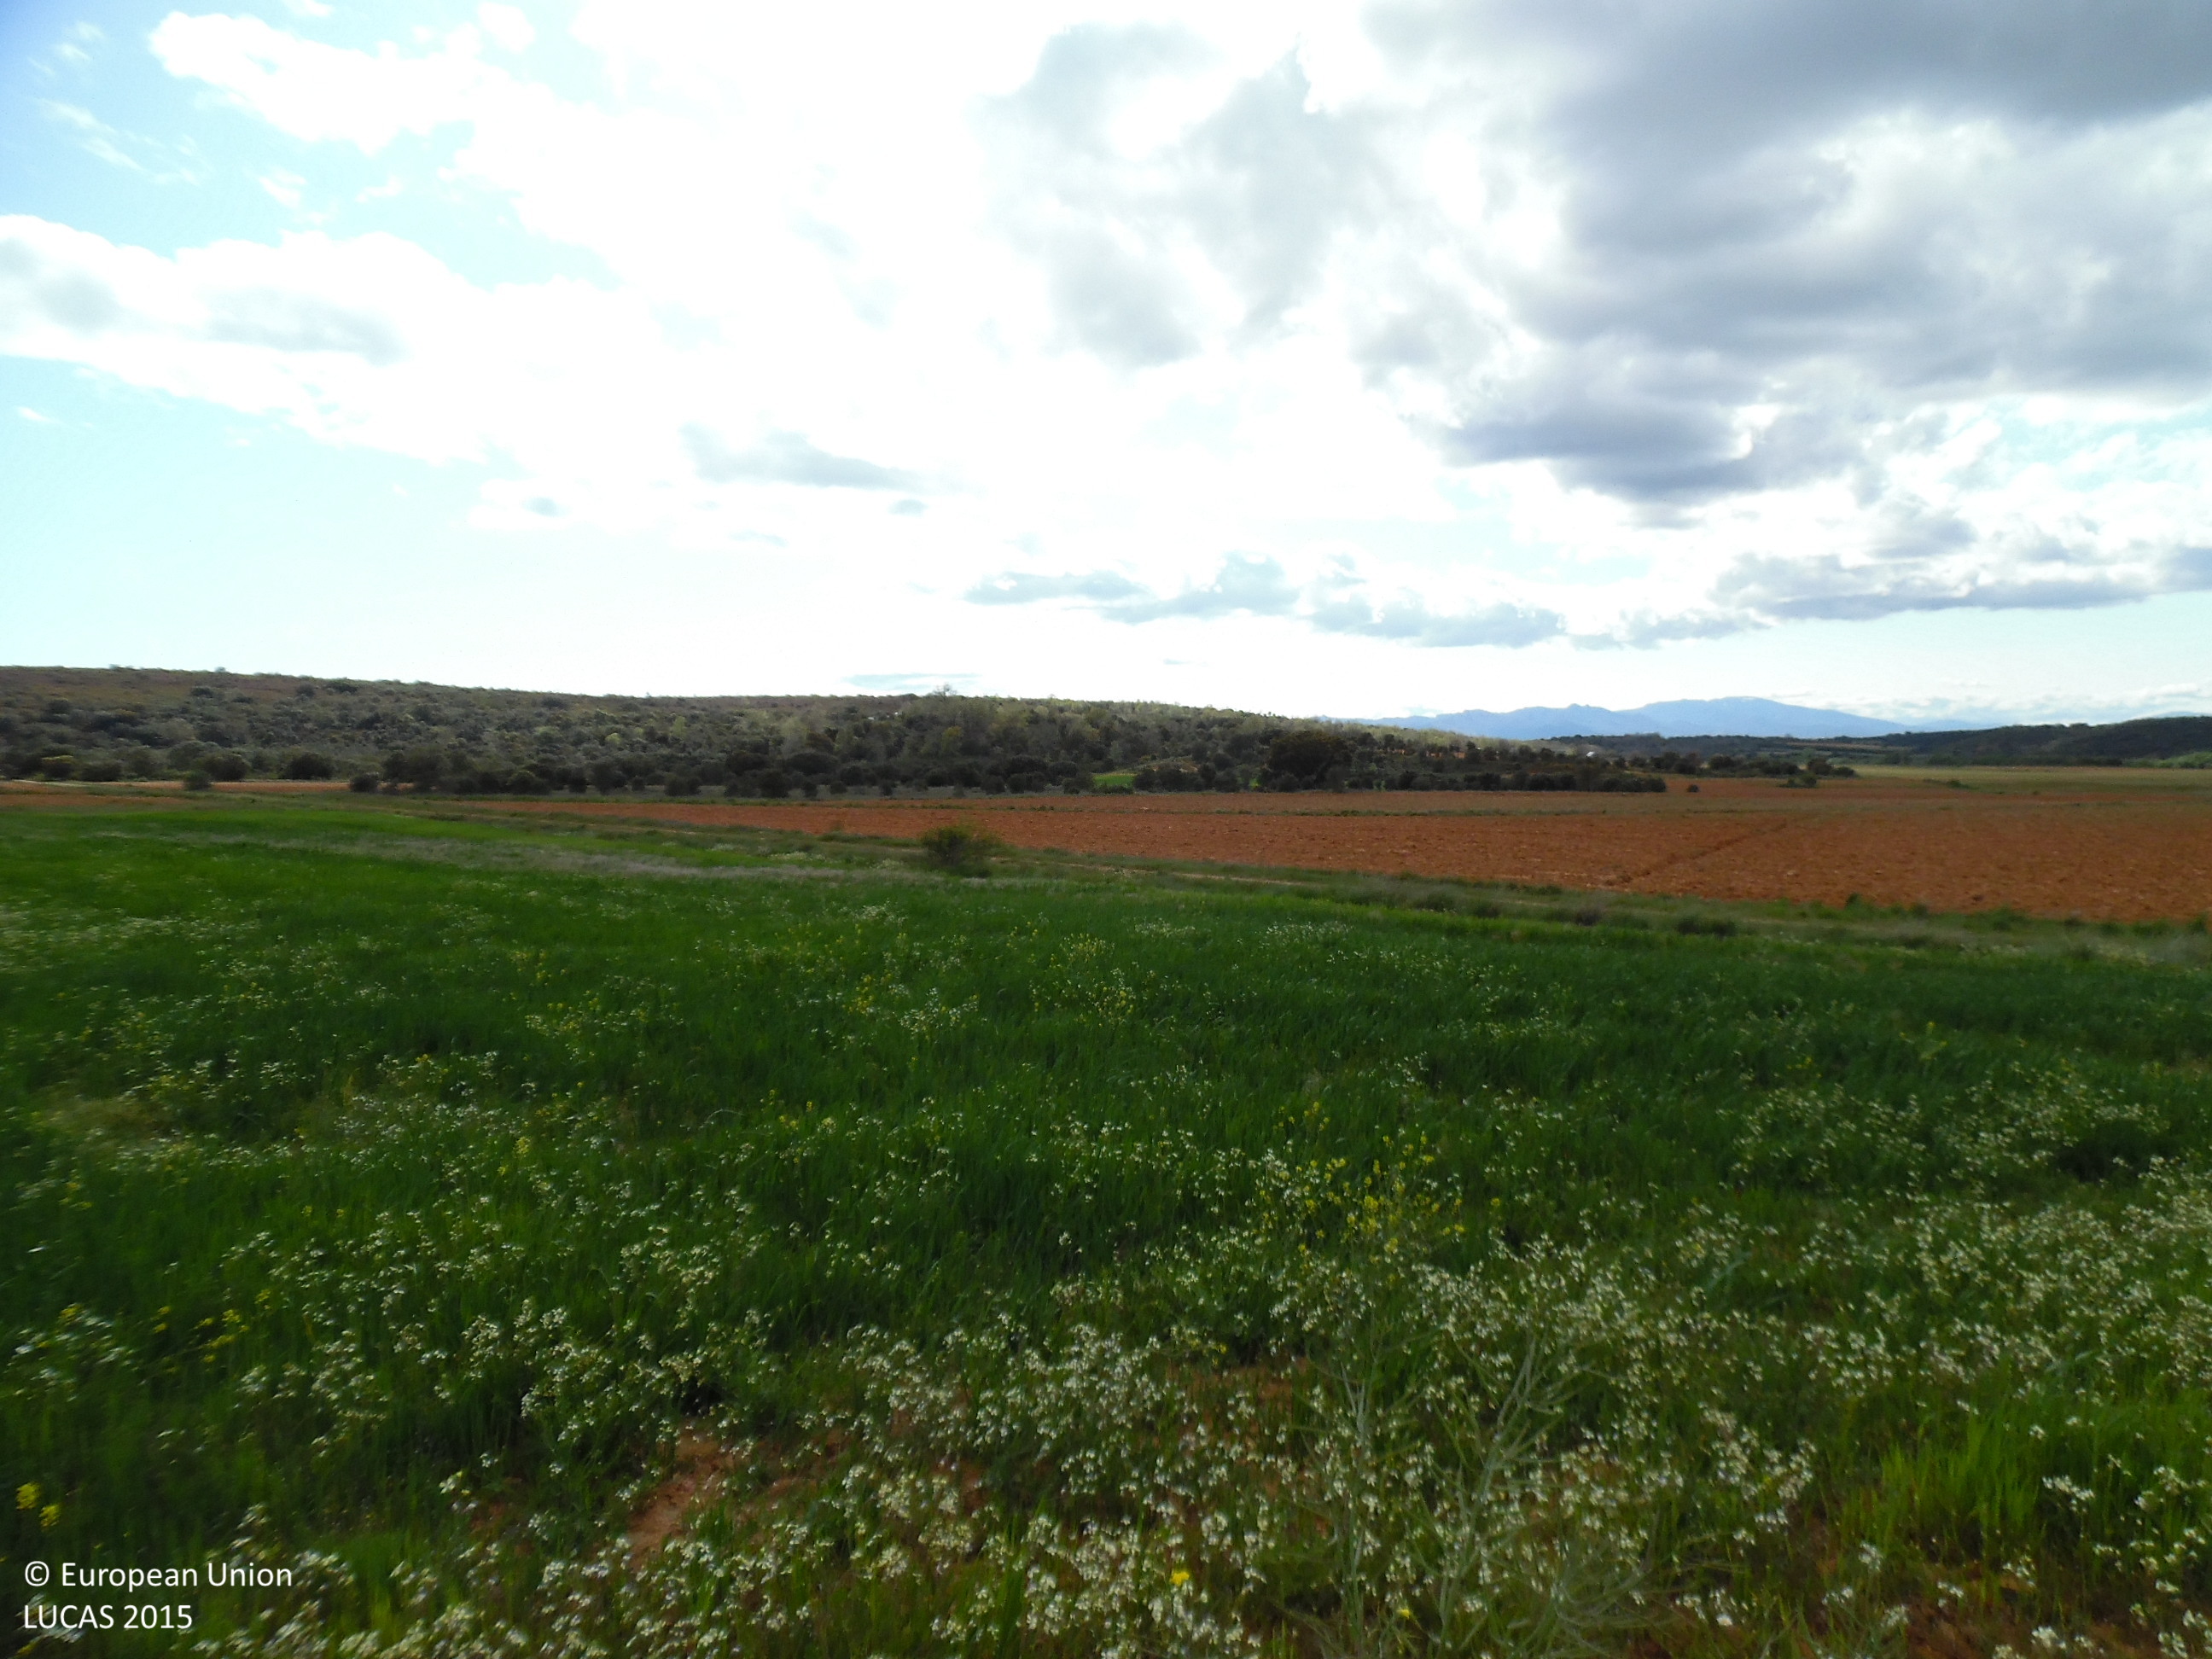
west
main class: Grassland
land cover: Spontaneously vegetated surfaces
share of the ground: > 75 %
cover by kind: herbaceous plants 100 %
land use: Fallow land
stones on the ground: 10 - 25 %
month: May
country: ES
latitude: 42.2556
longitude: -5.9930
